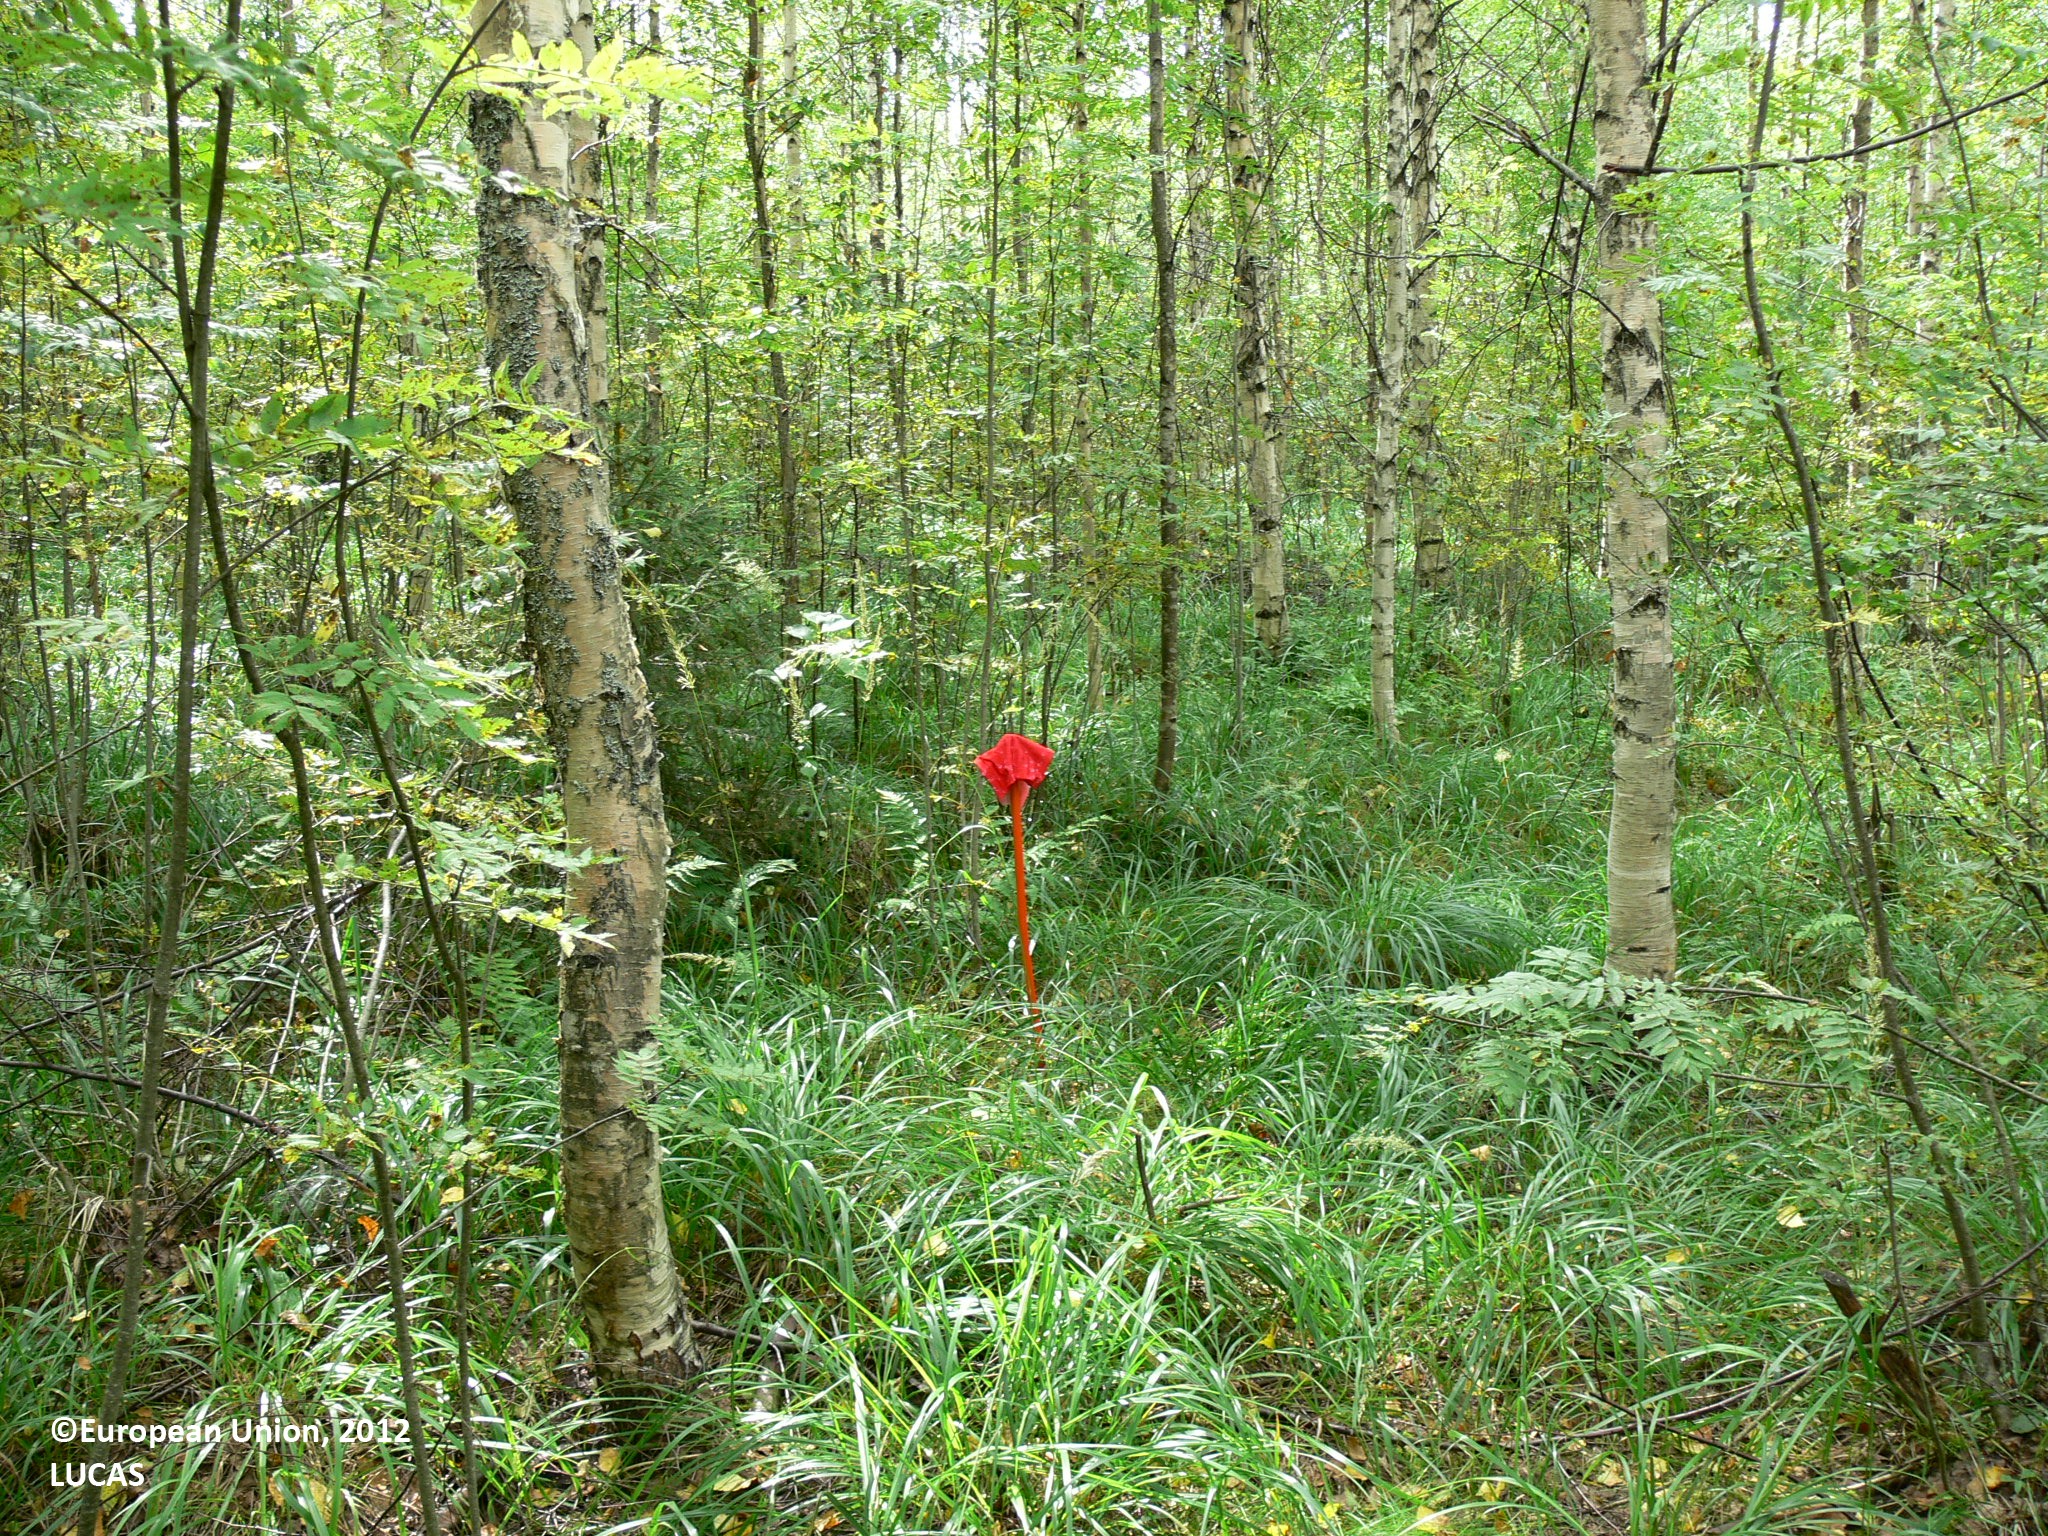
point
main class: Woodland
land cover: Broadleaved woodland
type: boreal forest
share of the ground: > 75 %
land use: Forestry
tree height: > 5 m
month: August
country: FI
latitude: 62.4422
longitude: 30.6941
